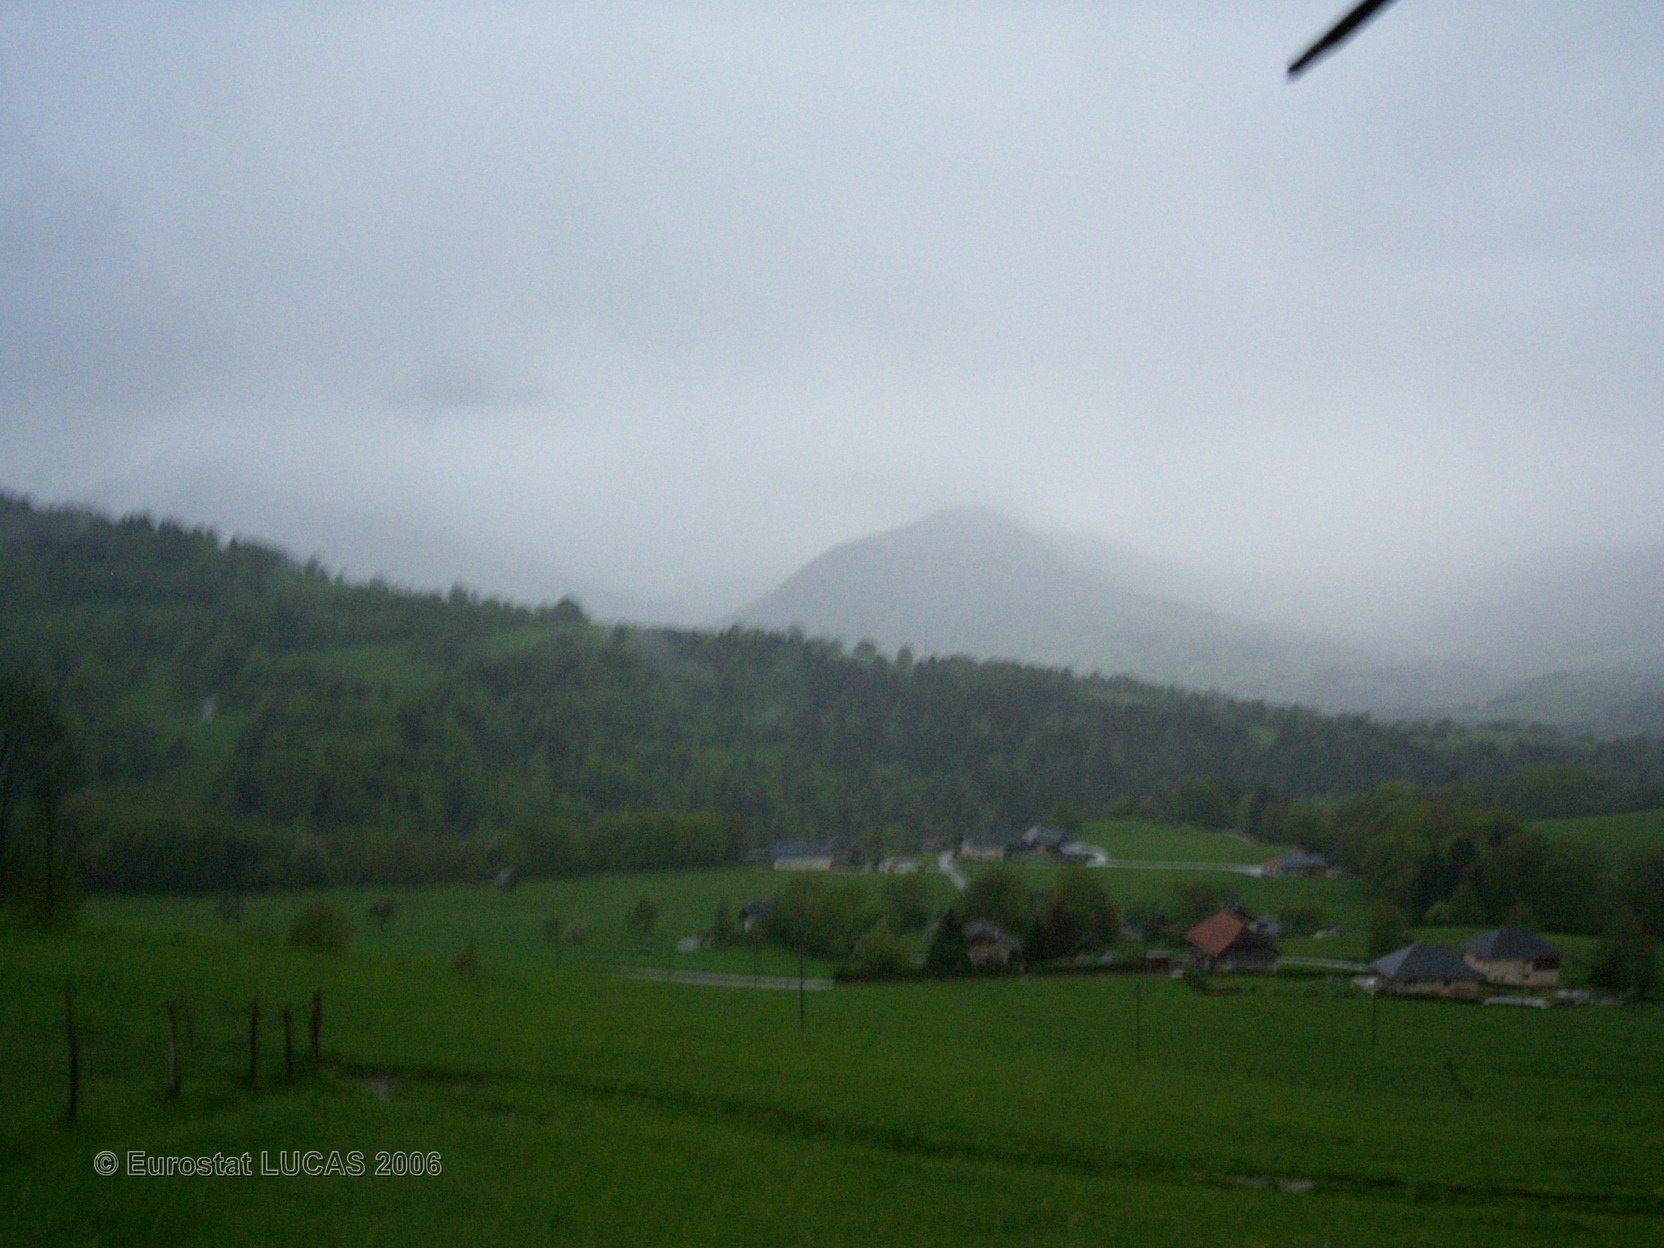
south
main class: Grassland
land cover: Grassland without tree/shrub cover
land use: Agriculture (excluding fallow land and kitchen gardens)
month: May
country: FR
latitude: 45.7404
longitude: 6.1357
